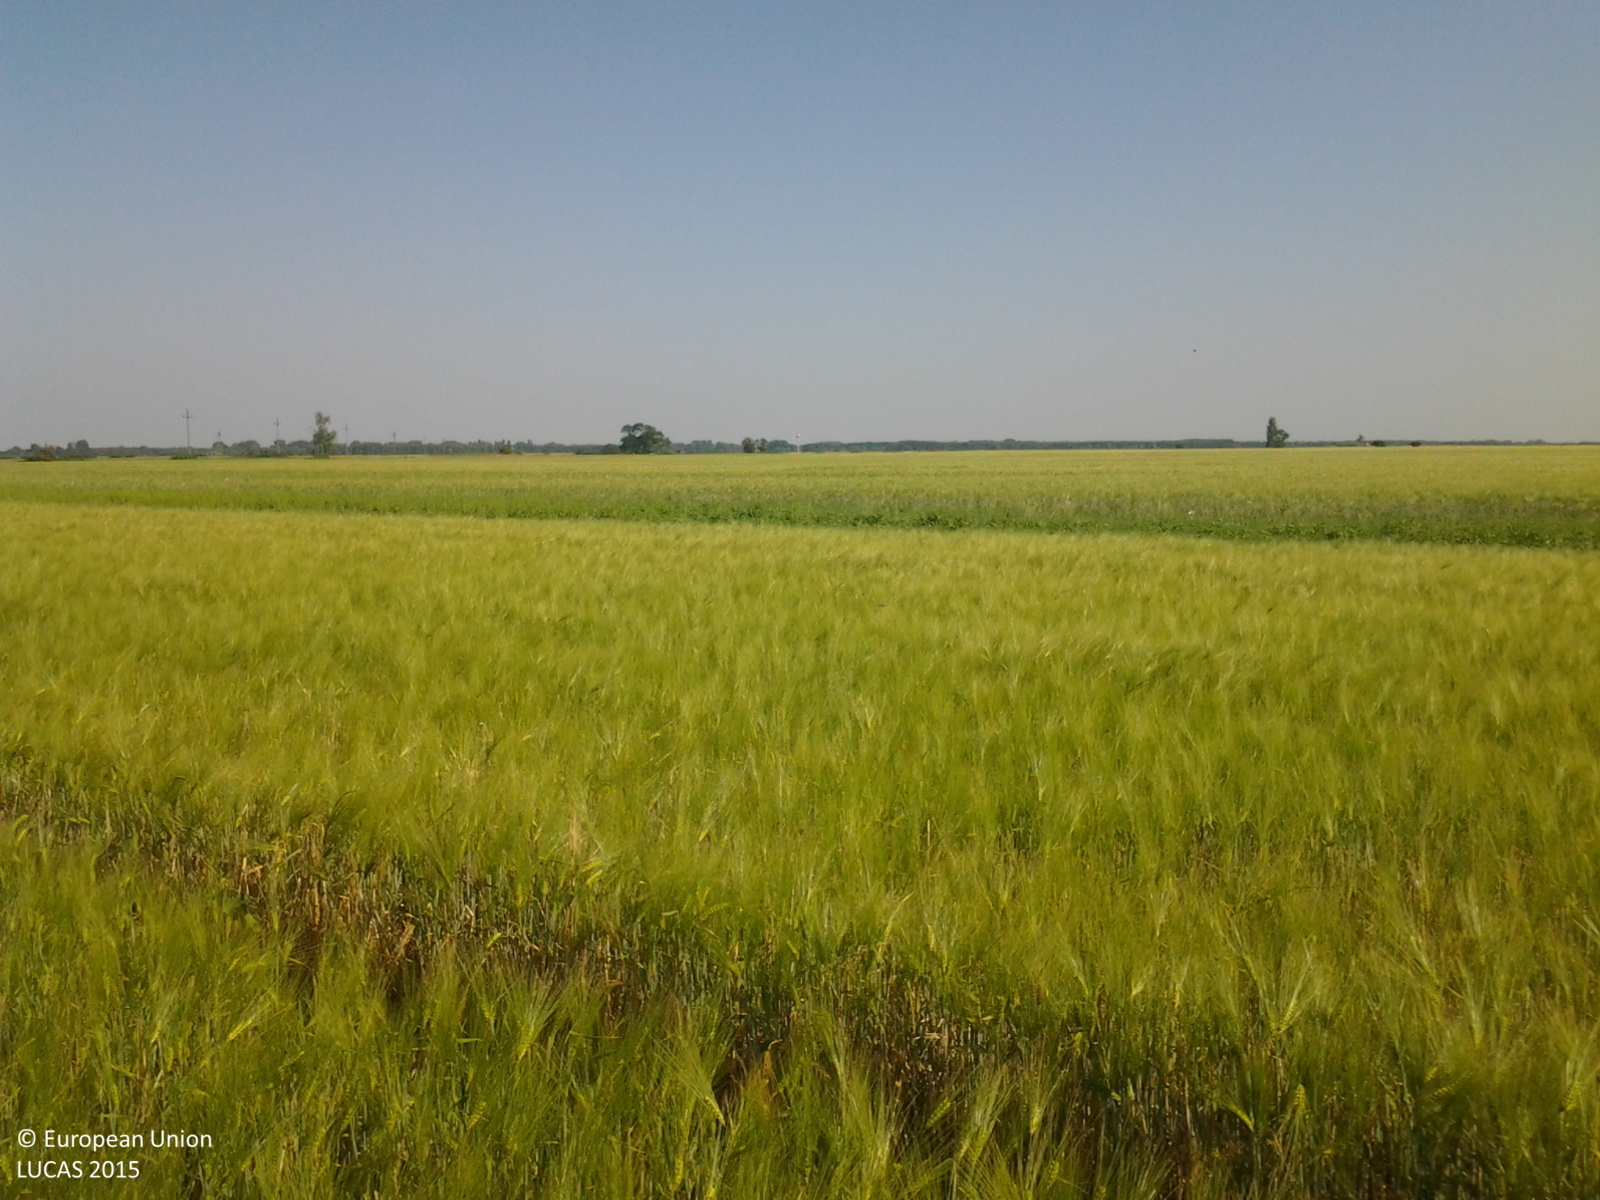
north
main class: Cropland
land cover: Barley
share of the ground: > 75 %
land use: Agriculture (excluding fallow land and kitchen gardens)
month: June
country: HU
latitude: 46.6001
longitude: 19.0610
